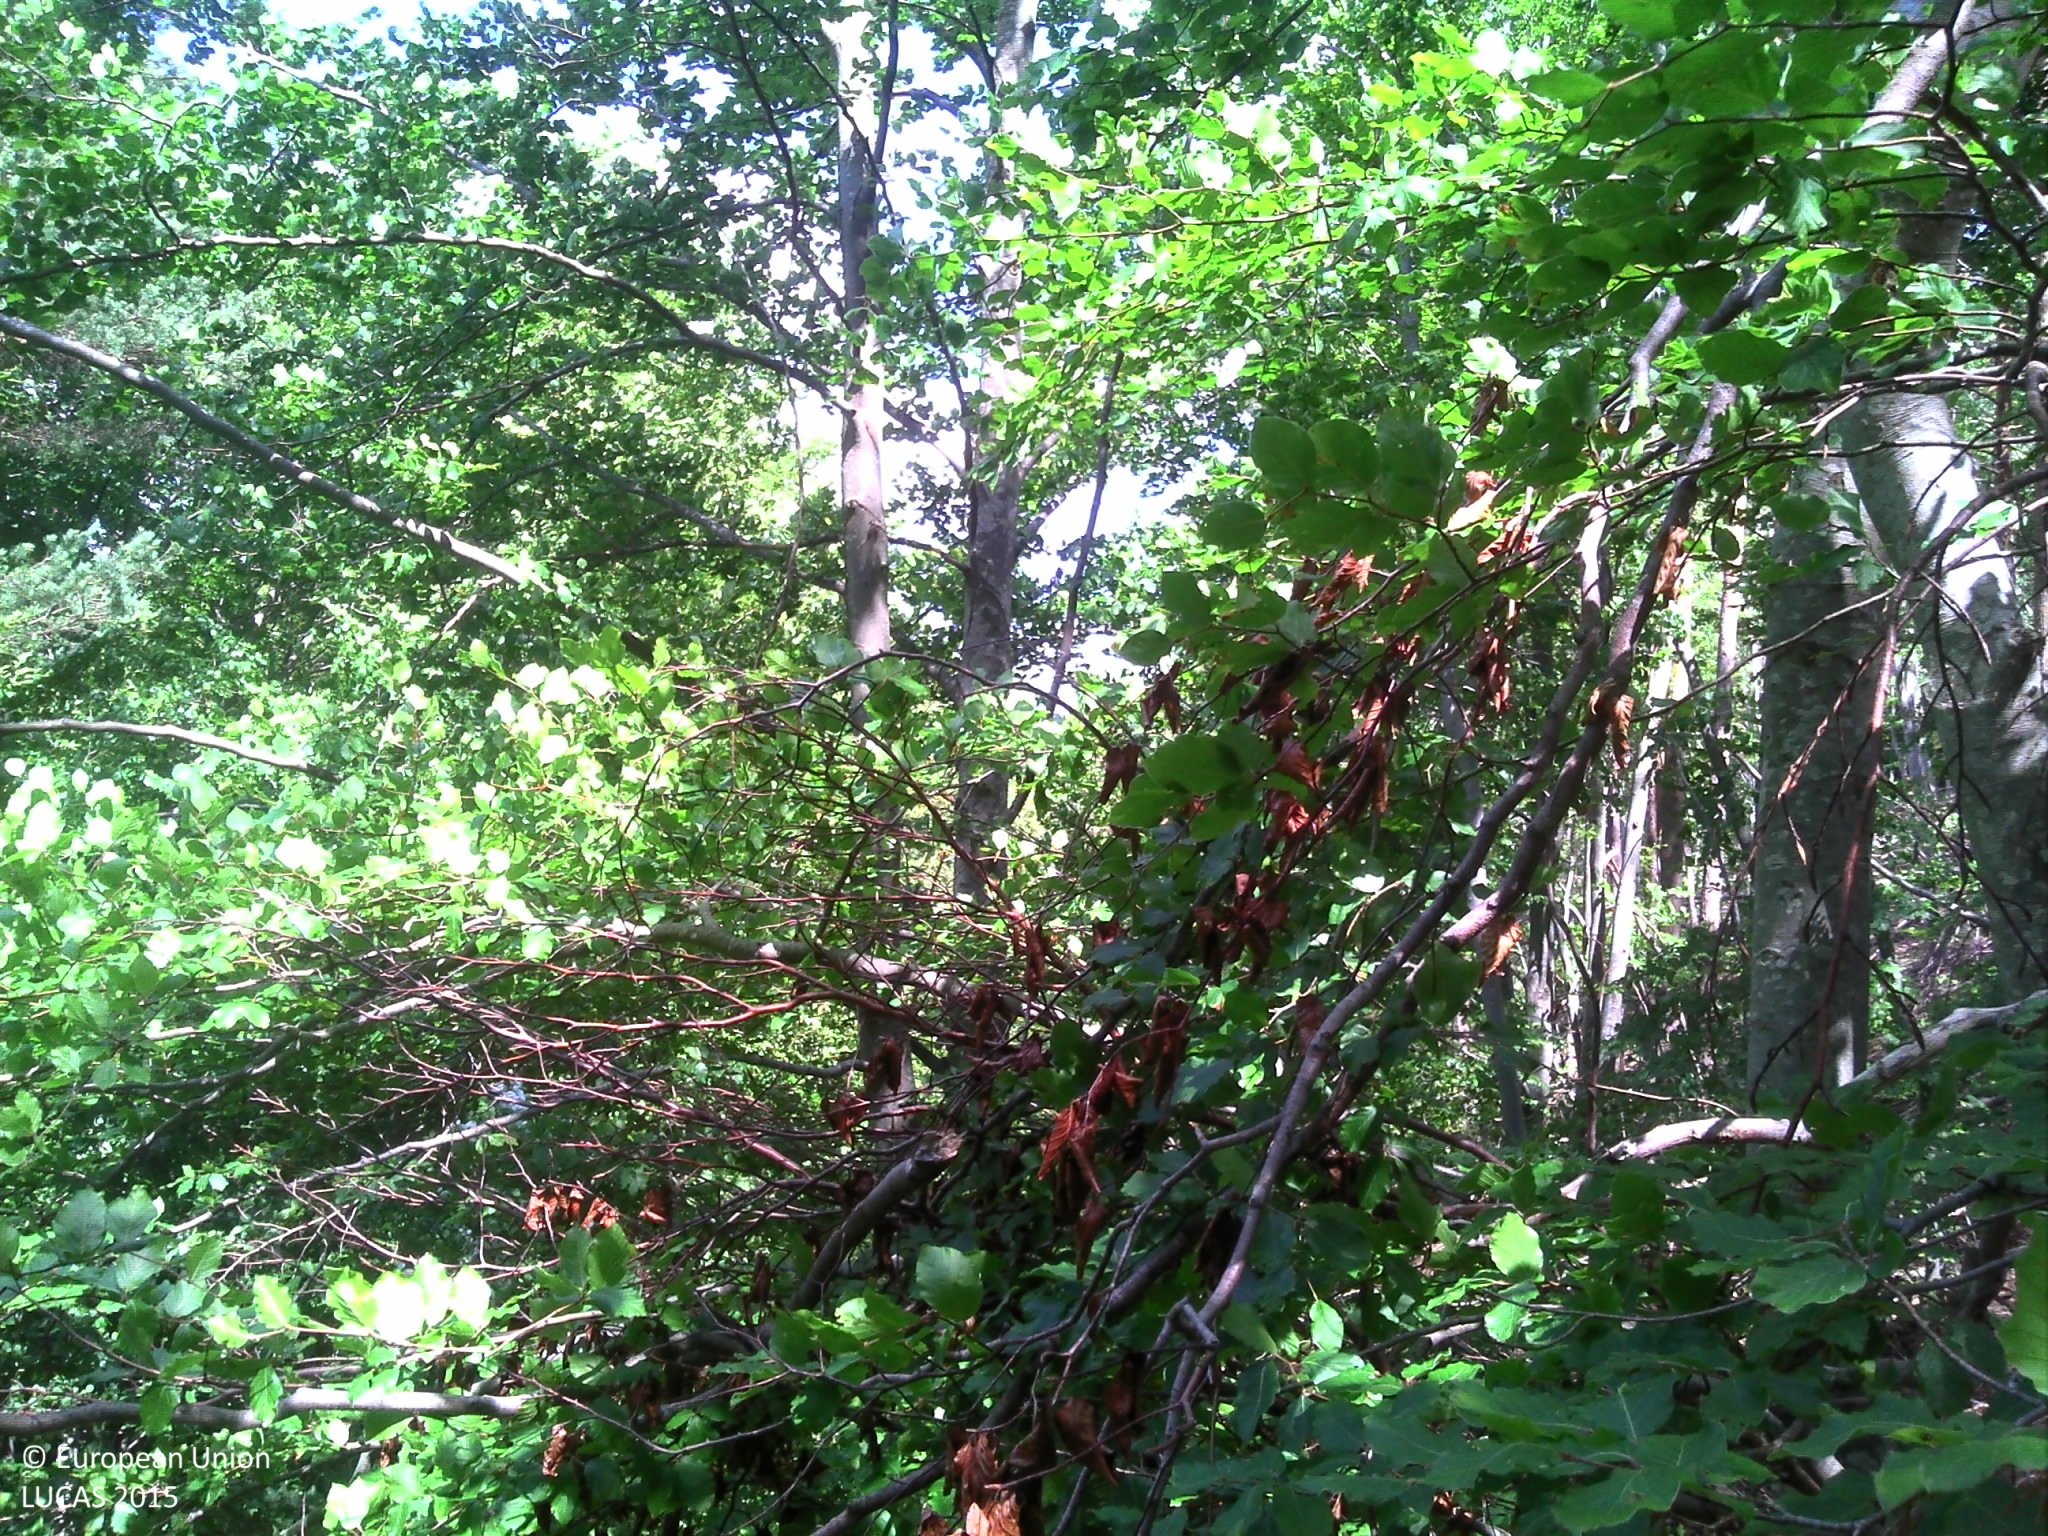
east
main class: Woodland
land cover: Other mixed woodland
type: mountainous beech forest
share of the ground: > 75 %
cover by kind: broadleaved forest trees 65 %, coniferous forest trees 25 %, herbaceous plants 10 %
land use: Forestry
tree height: > 5 m
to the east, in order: Other mixed woodland; Tracks; Other mixed woodland
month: June
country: FR
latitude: 44.5703
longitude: 3.9238
